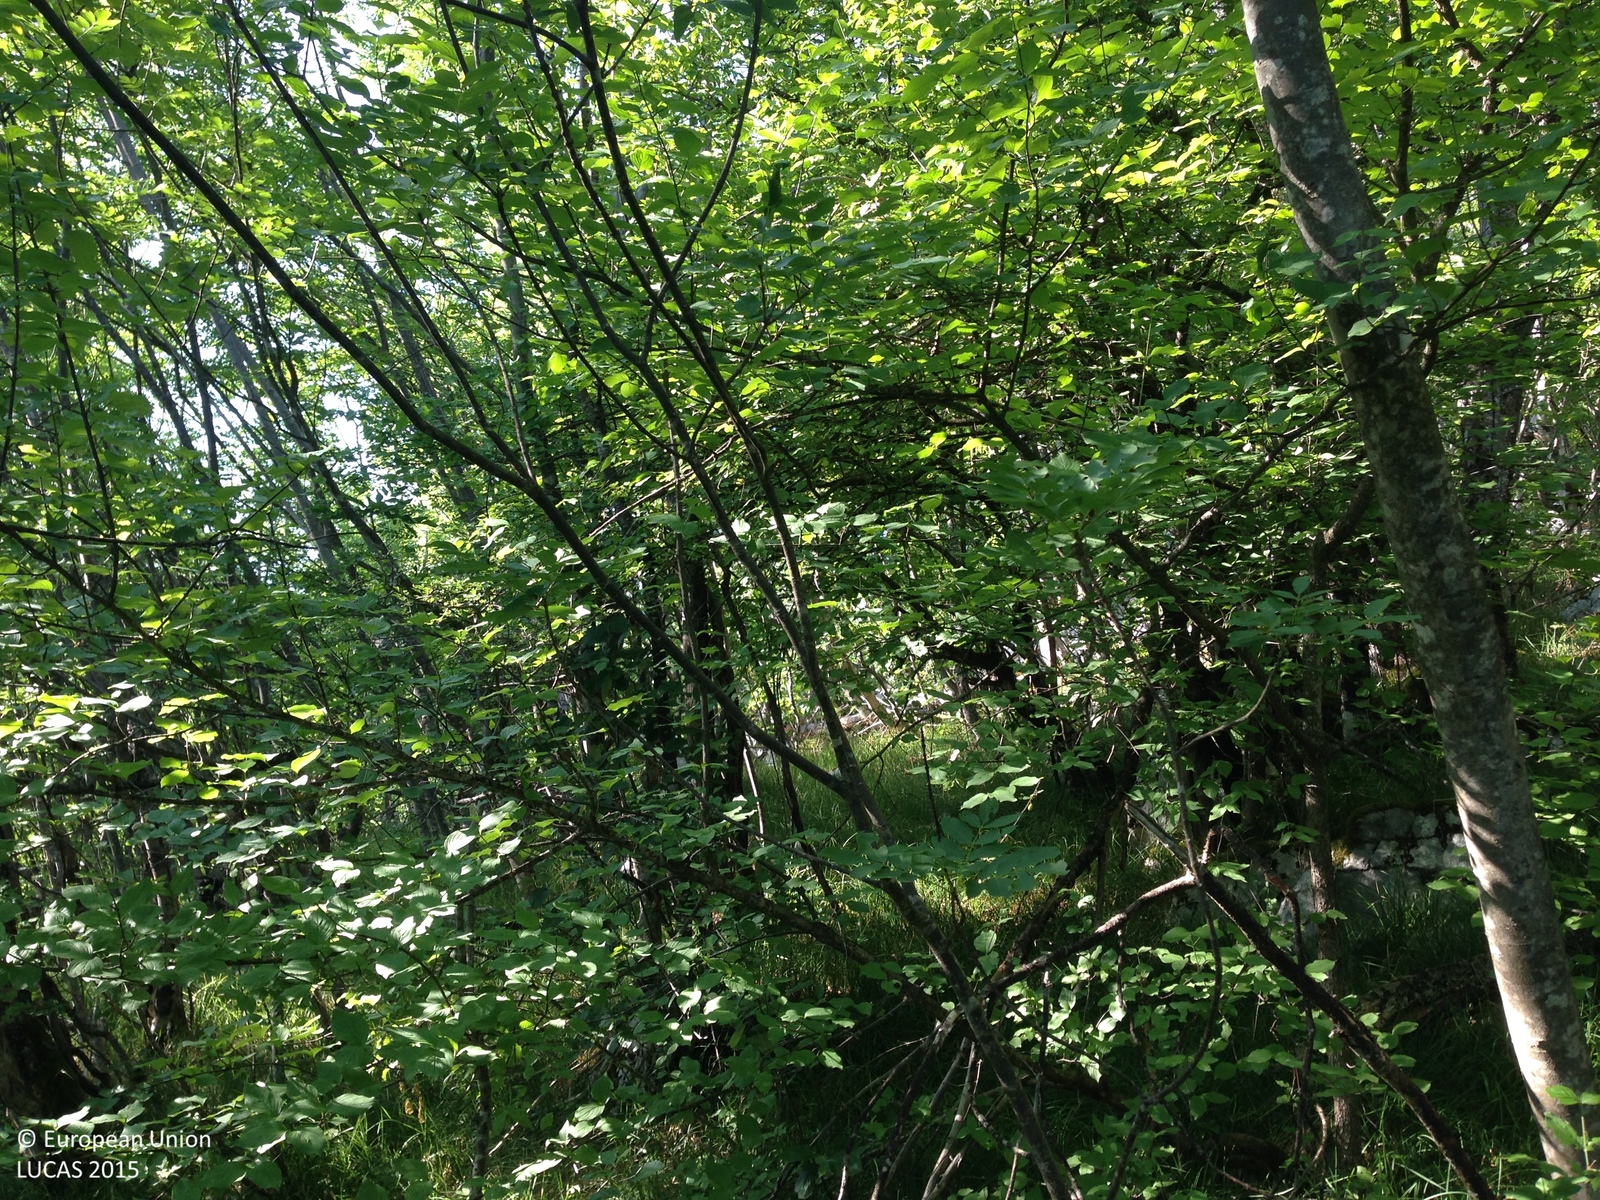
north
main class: Woodland
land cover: Broadleaved woodland
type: thermophilous deciduous forest
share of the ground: > 75 %
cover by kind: broadleaved forest trees 55 %, herbaceous plants 20 %, lichens and mosses 10 %, consolidated bare surface 10 %, unconsolidated bare surface 5 %
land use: Forestry
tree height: > 5 m
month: July
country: HR
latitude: 44.7821
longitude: 15.1629
